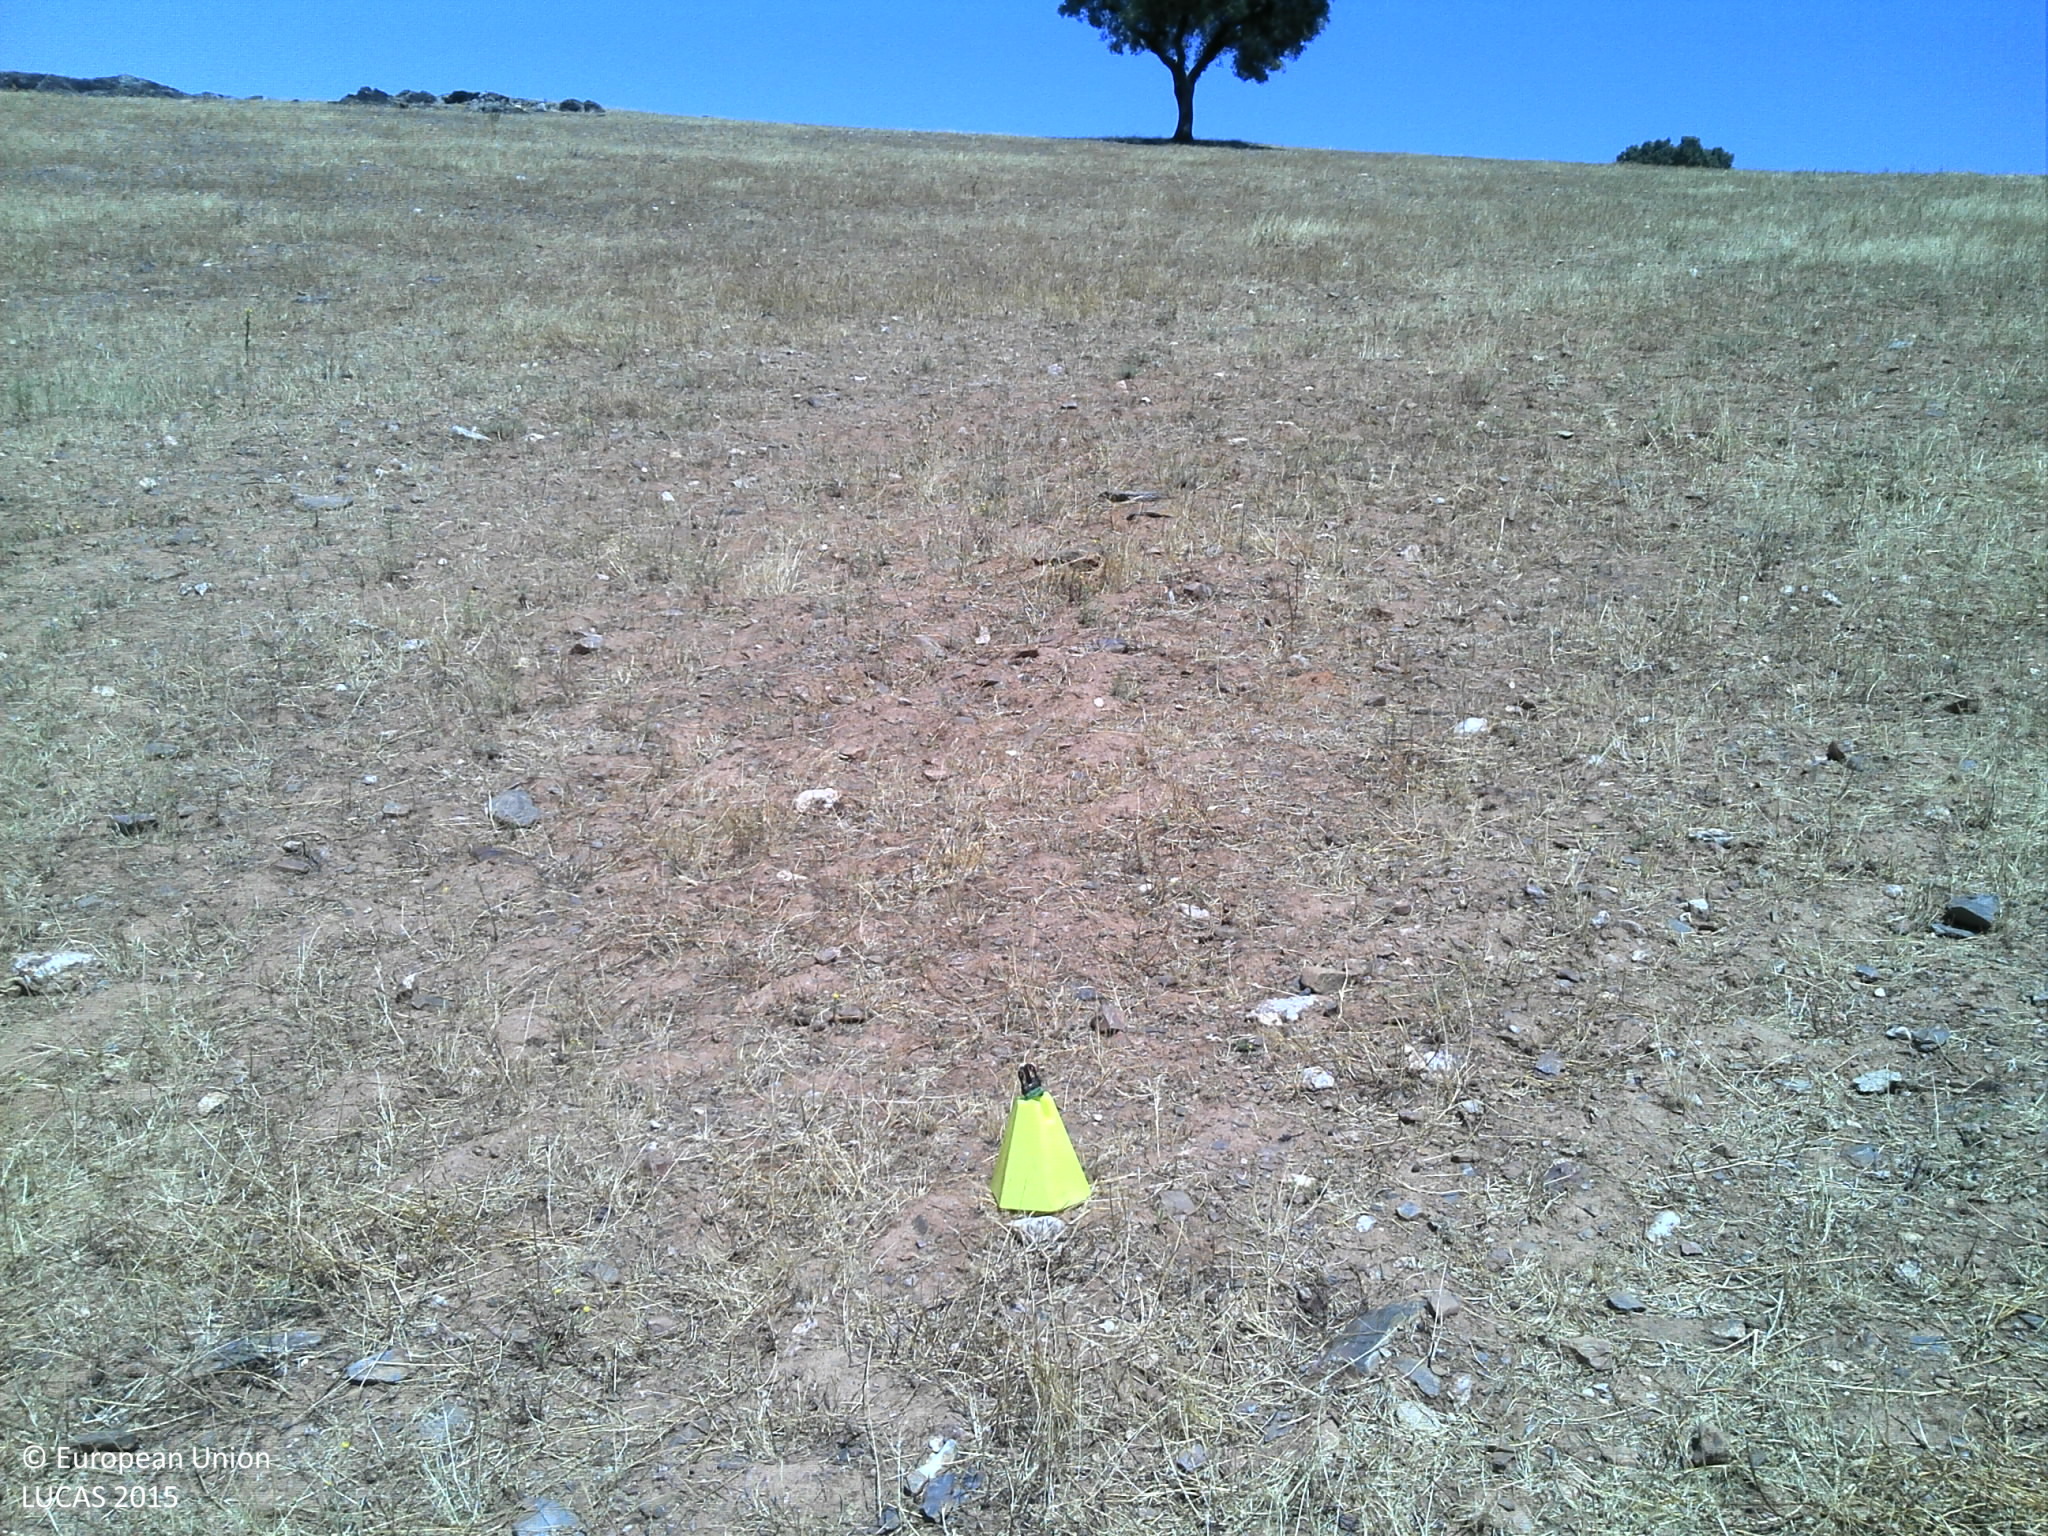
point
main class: Grassland
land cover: Grassland without tree/shrub cover
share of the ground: 25 - 50 %
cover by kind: unconsolidated bare surface 75 %, herbaceous plants 25 %
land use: Agriculture (excluding fallow land and kitchen gardens)
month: July
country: PT
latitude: 38.9498
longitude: -7.5418
